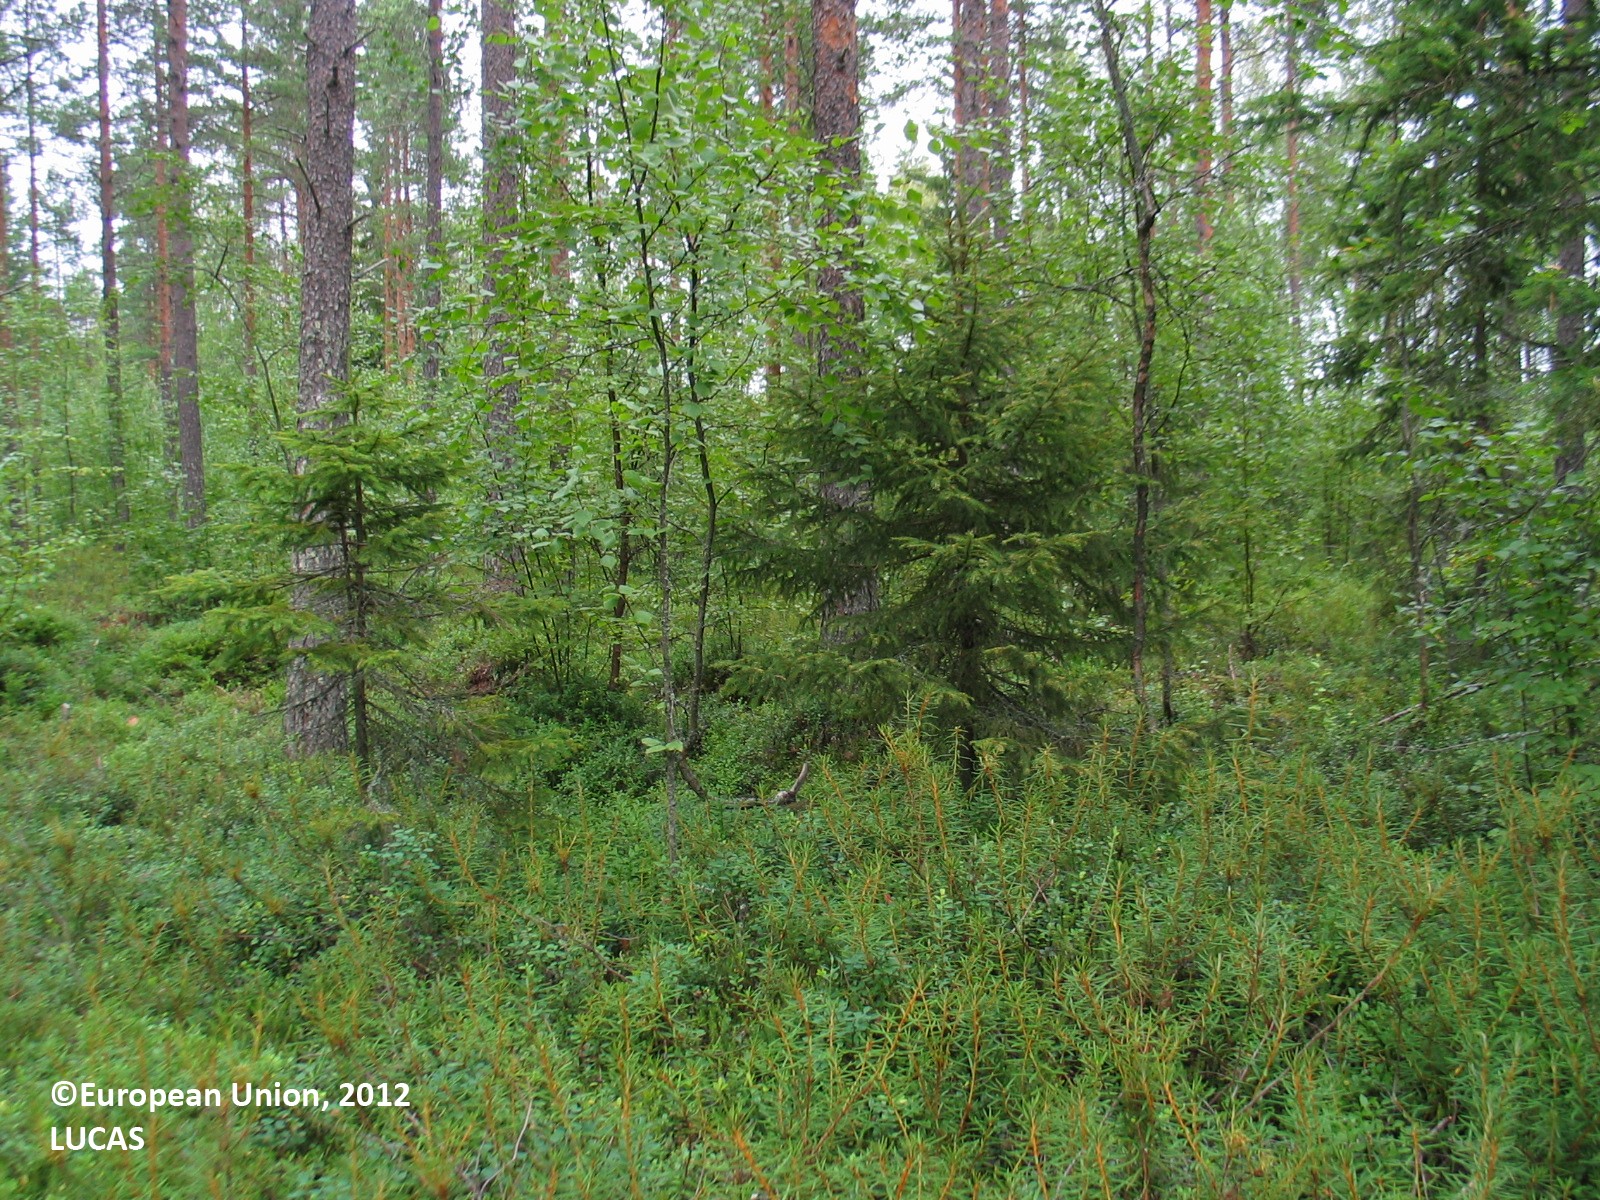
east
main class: Woodland
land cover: Pine dominated coniferous woodland
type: boreal forest
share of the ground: 25 - 50 %
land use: Forestry
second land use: Amenities, museums, leisure
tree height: > 5 m
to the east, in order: Pine dominated coniferous woodland; Ditches and canals; Pine dominated coniferous woodland; Ditches and canals; Abandoned hedges; Tracks; Pine dominated coniferous woodland; Ditches and canals; Pine dominated coniferous woodland; Other mixed woodland; Ditches and canals; Other mixed woodland; Pine dominated coniferous woodland; Ditches and canals; Other mixed woodland; Spruce dominated mixed woodland
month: August
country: FI
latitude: 65.0939
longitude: 25.4684
